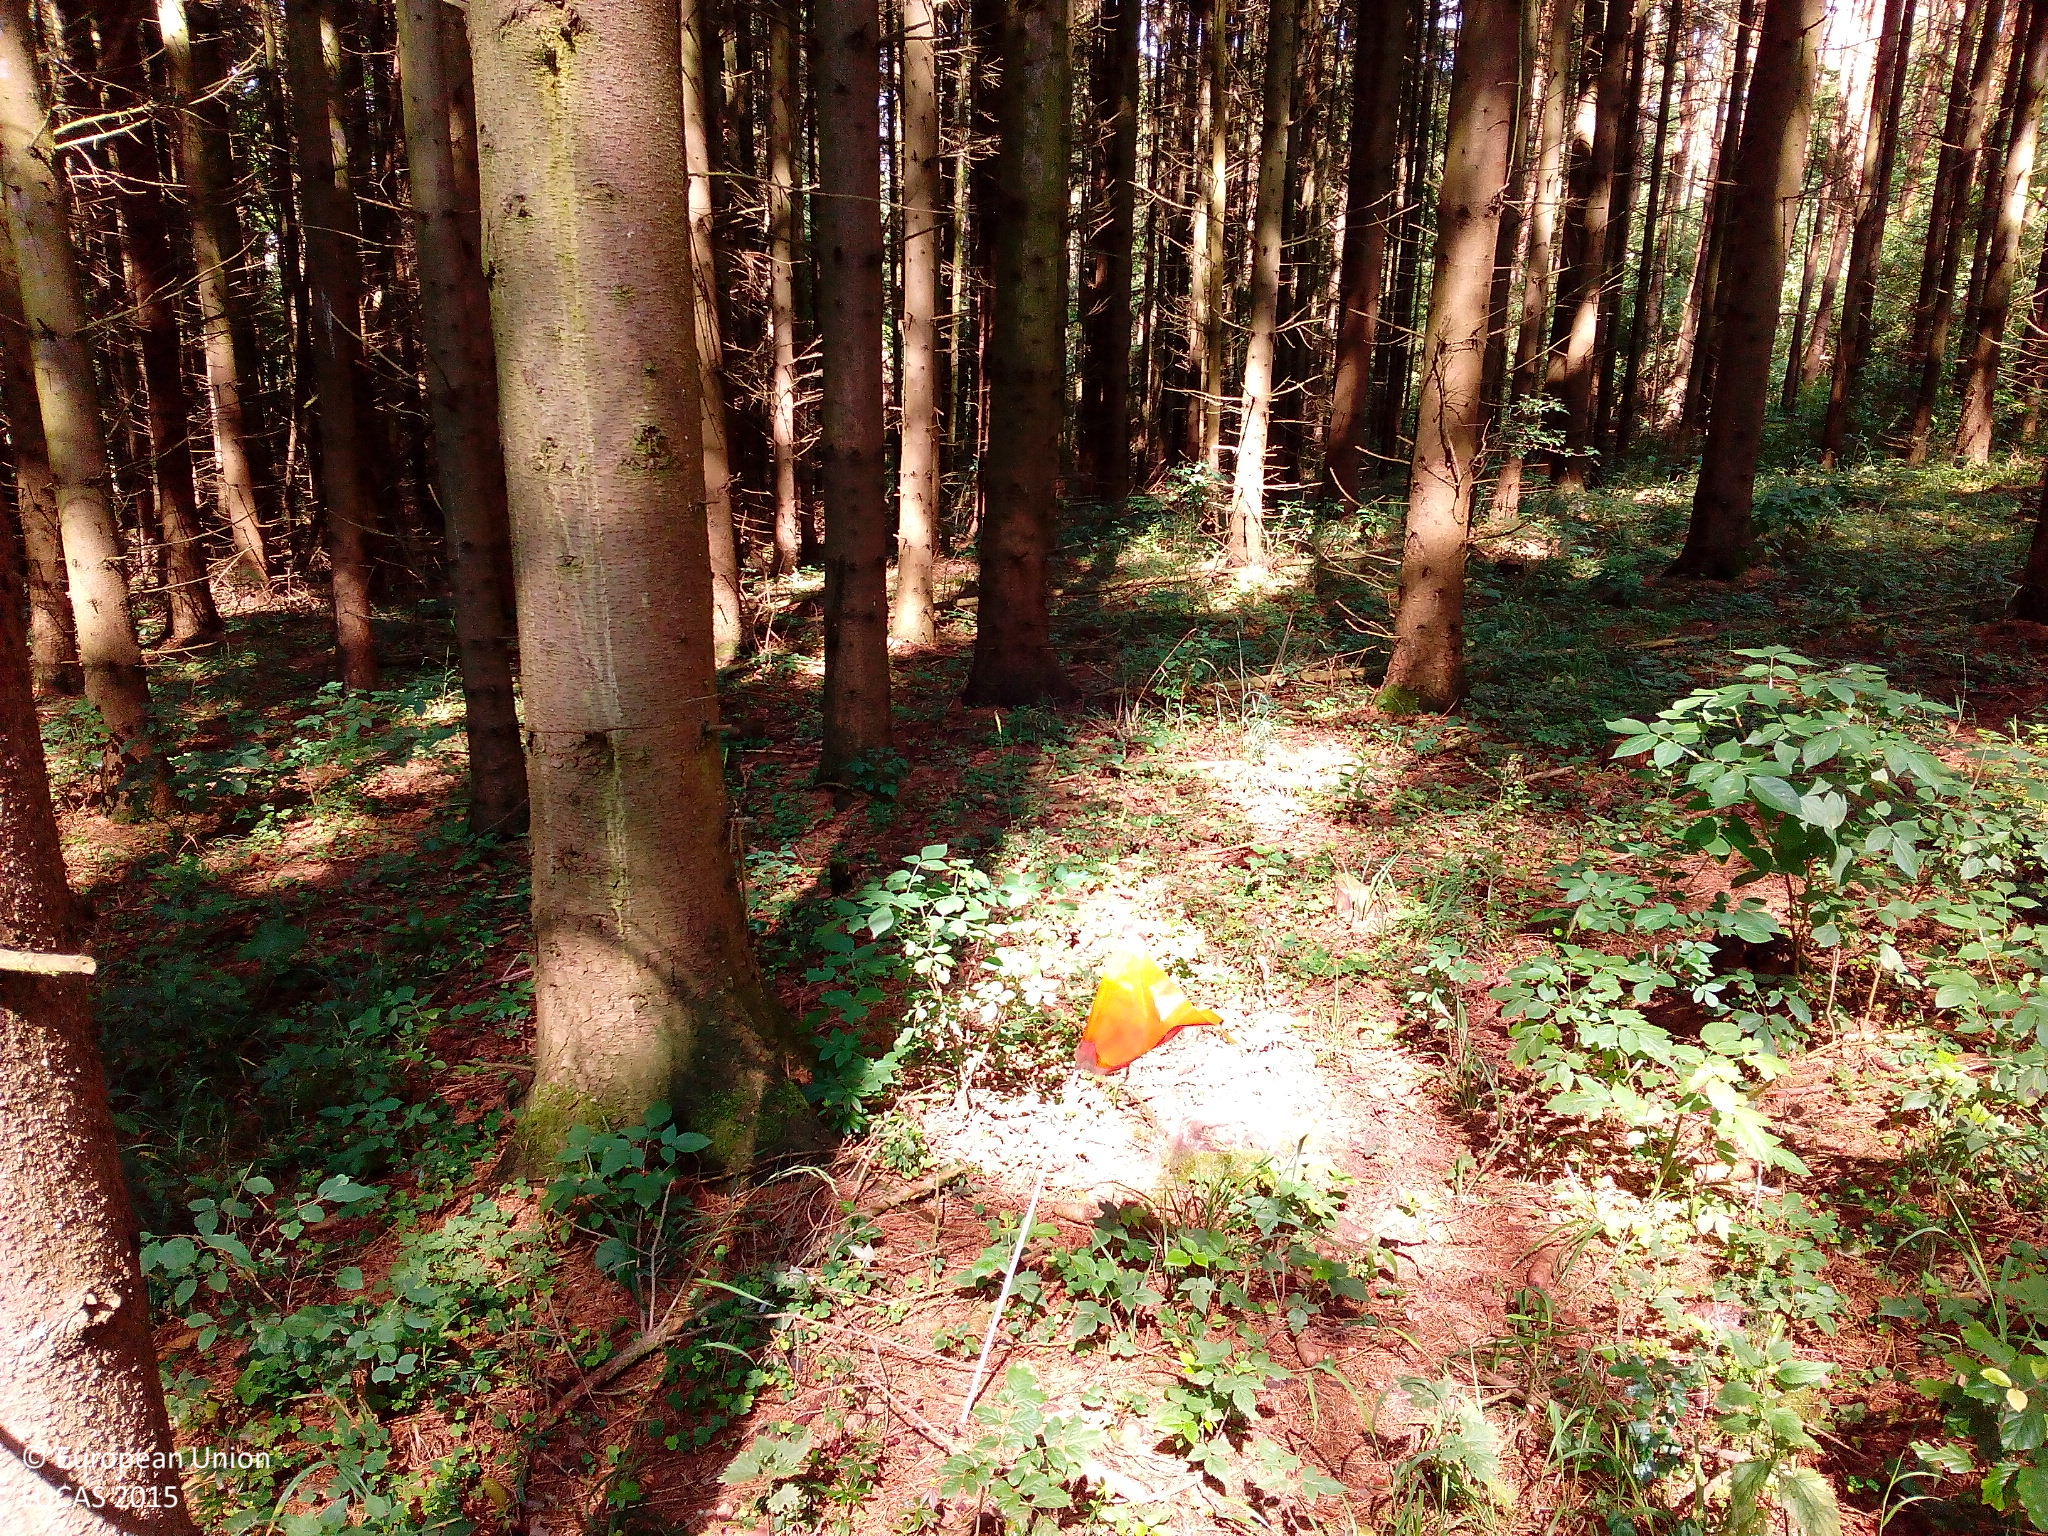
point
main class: Woodland
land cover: Spruce dominated coniferous woodland
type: hemiboreal forest and nemoral coniferous forest and mixed broadleaved-coniferous forest
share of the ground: > 75 %
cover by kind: coniferous forest trees 90 %, broadleaved forest trees 5 %, herbaceous plants 5 %
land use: Forestry
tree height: > 5 m
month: July
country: DE
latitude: 50.6517
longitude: 9.9576
